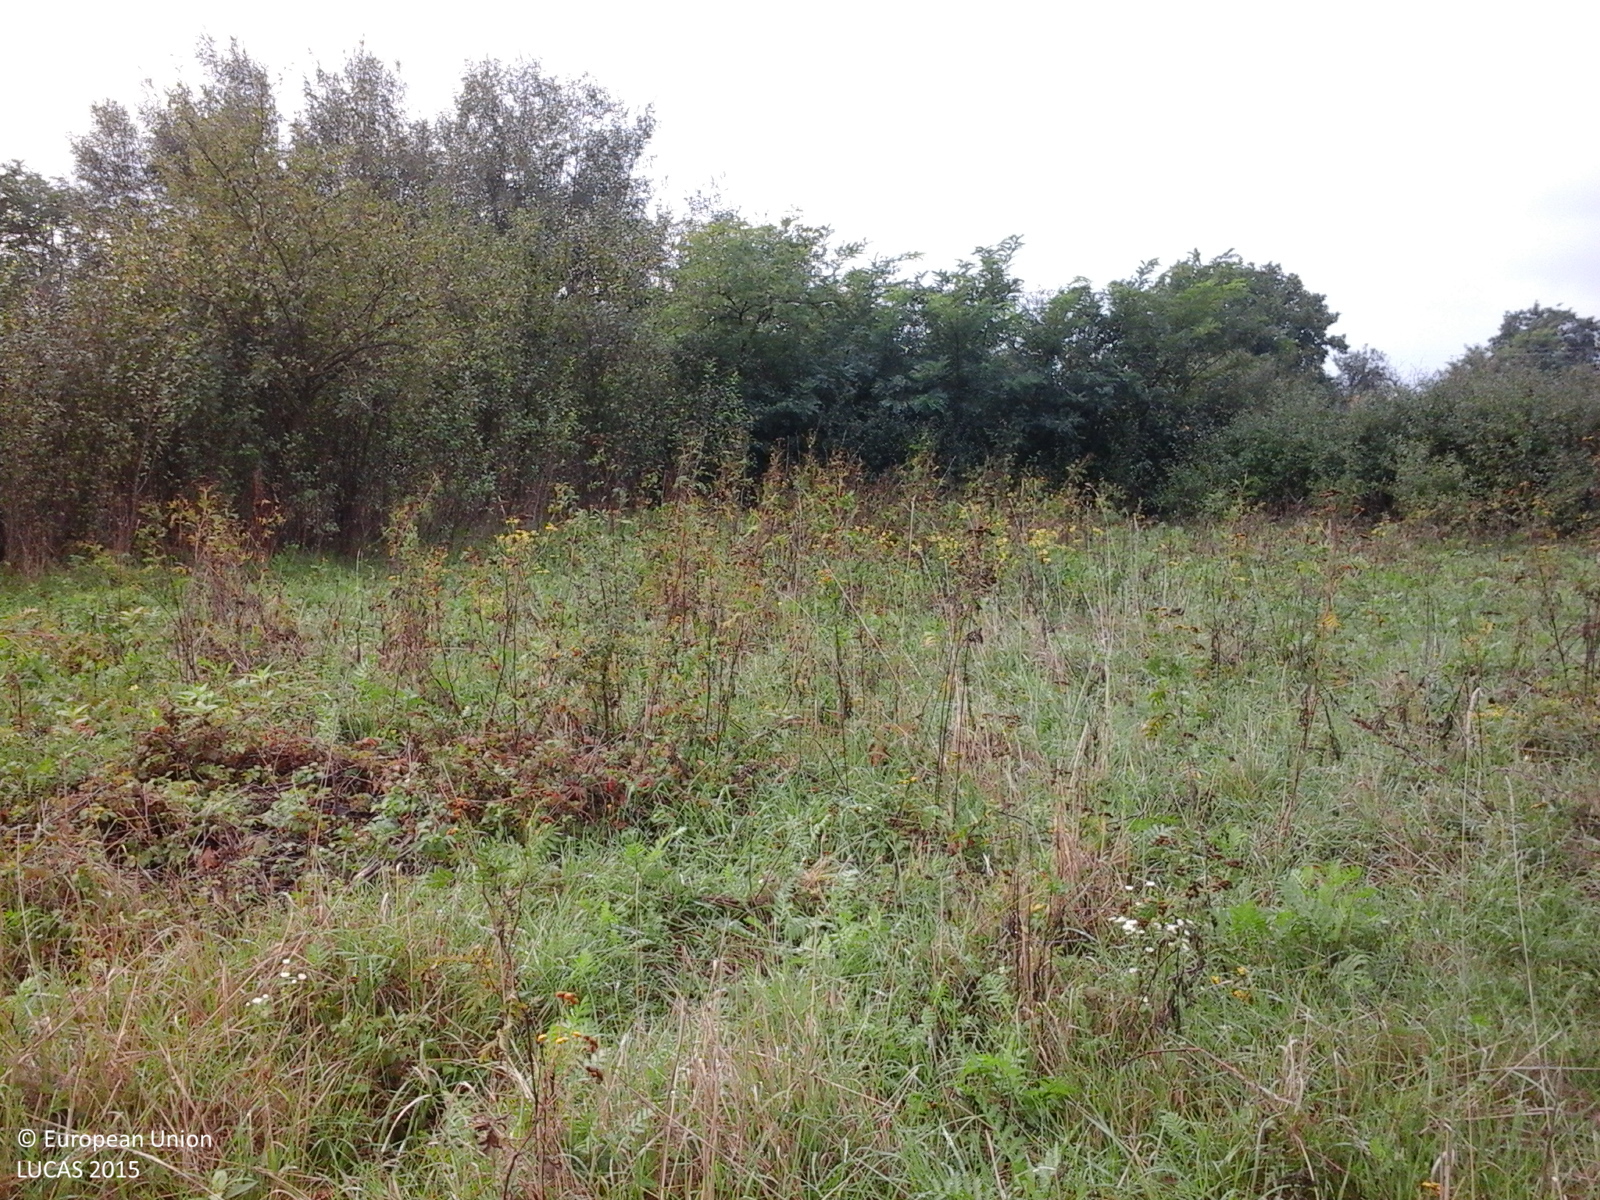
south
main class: Grassland
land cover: Grassland with sparse tree/shrub cover
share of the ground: > 75 %
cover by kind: herbaceous plants 85 %, shrubs 10 %, broadleaved forest trees 5 %
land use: Agriculture (excluding fallow land and kitchen gardens)
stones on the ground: < 10 %
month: September
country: RO
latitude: 46.7168
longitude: 21.7773
